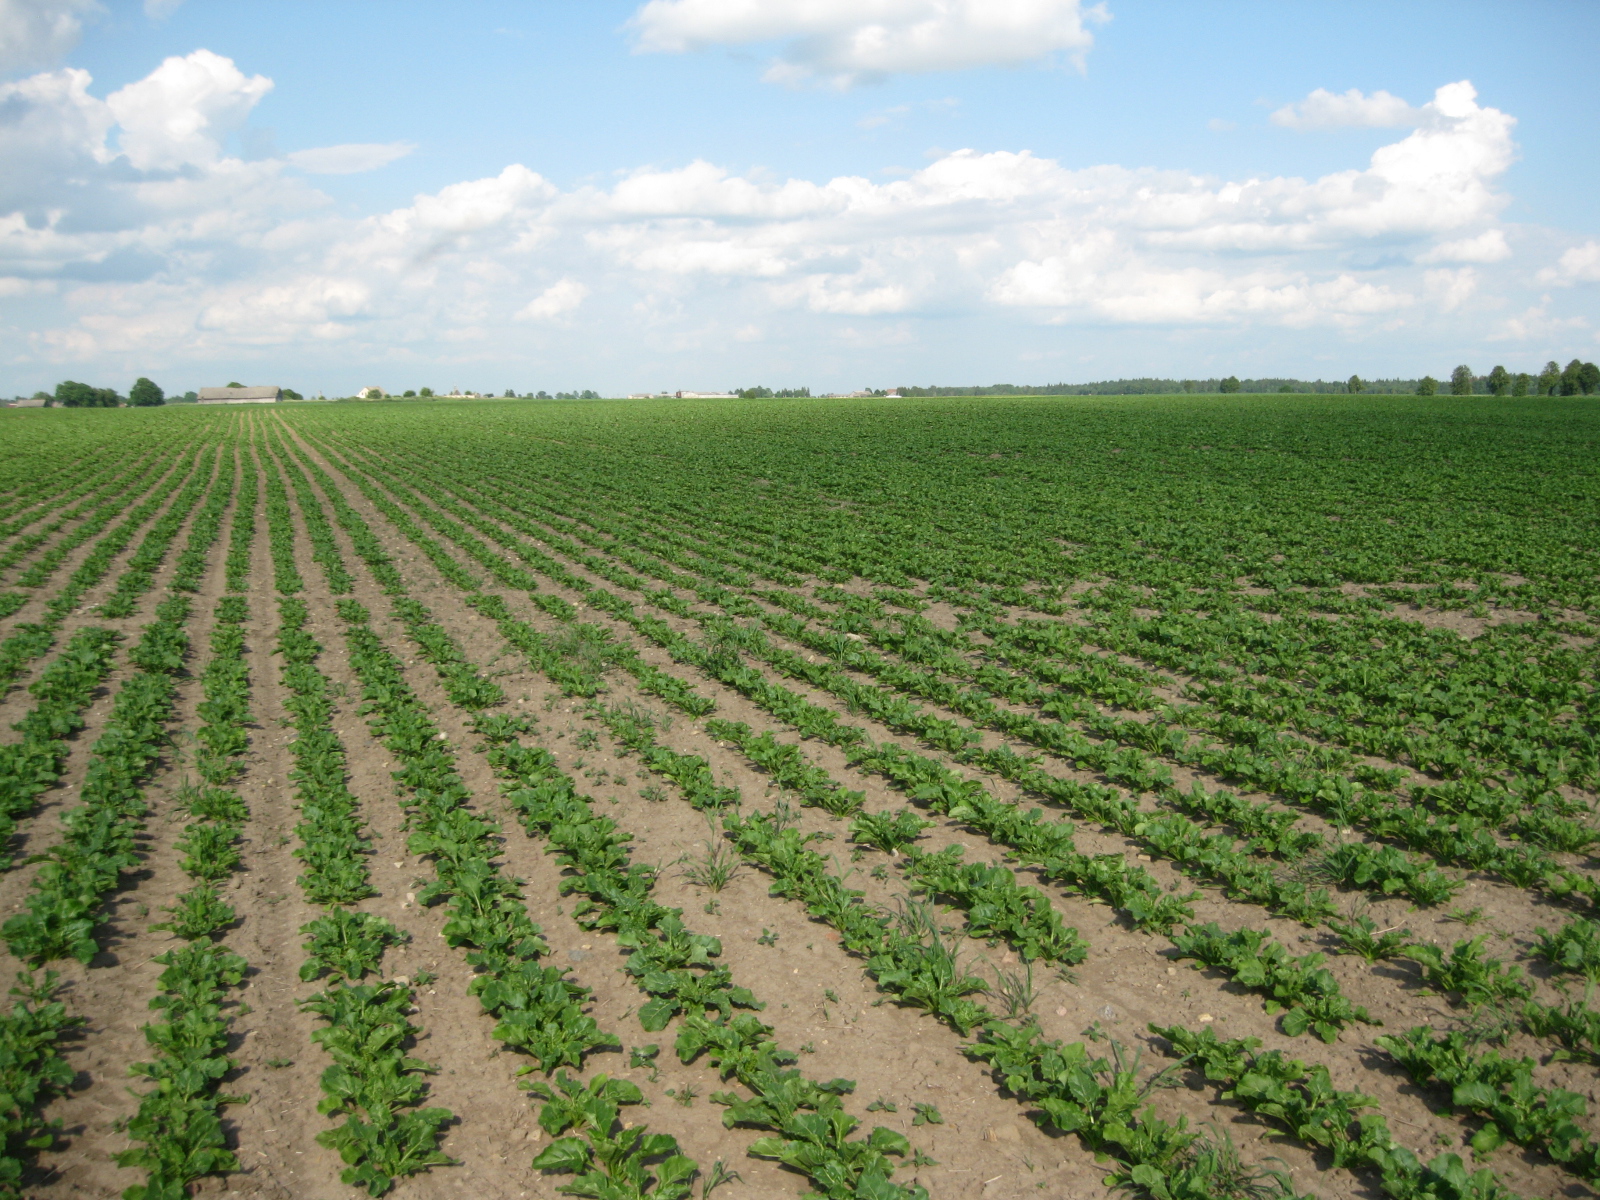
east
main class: Cropland
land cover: Sugar beet
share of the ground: 25 - 50 %
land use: Agriculture (excluding fallow land and kitchen gardens)
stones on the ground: < 10 %
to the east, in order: Sugar beet
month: June
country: LT
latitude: 55.5616
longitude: 23.8321
